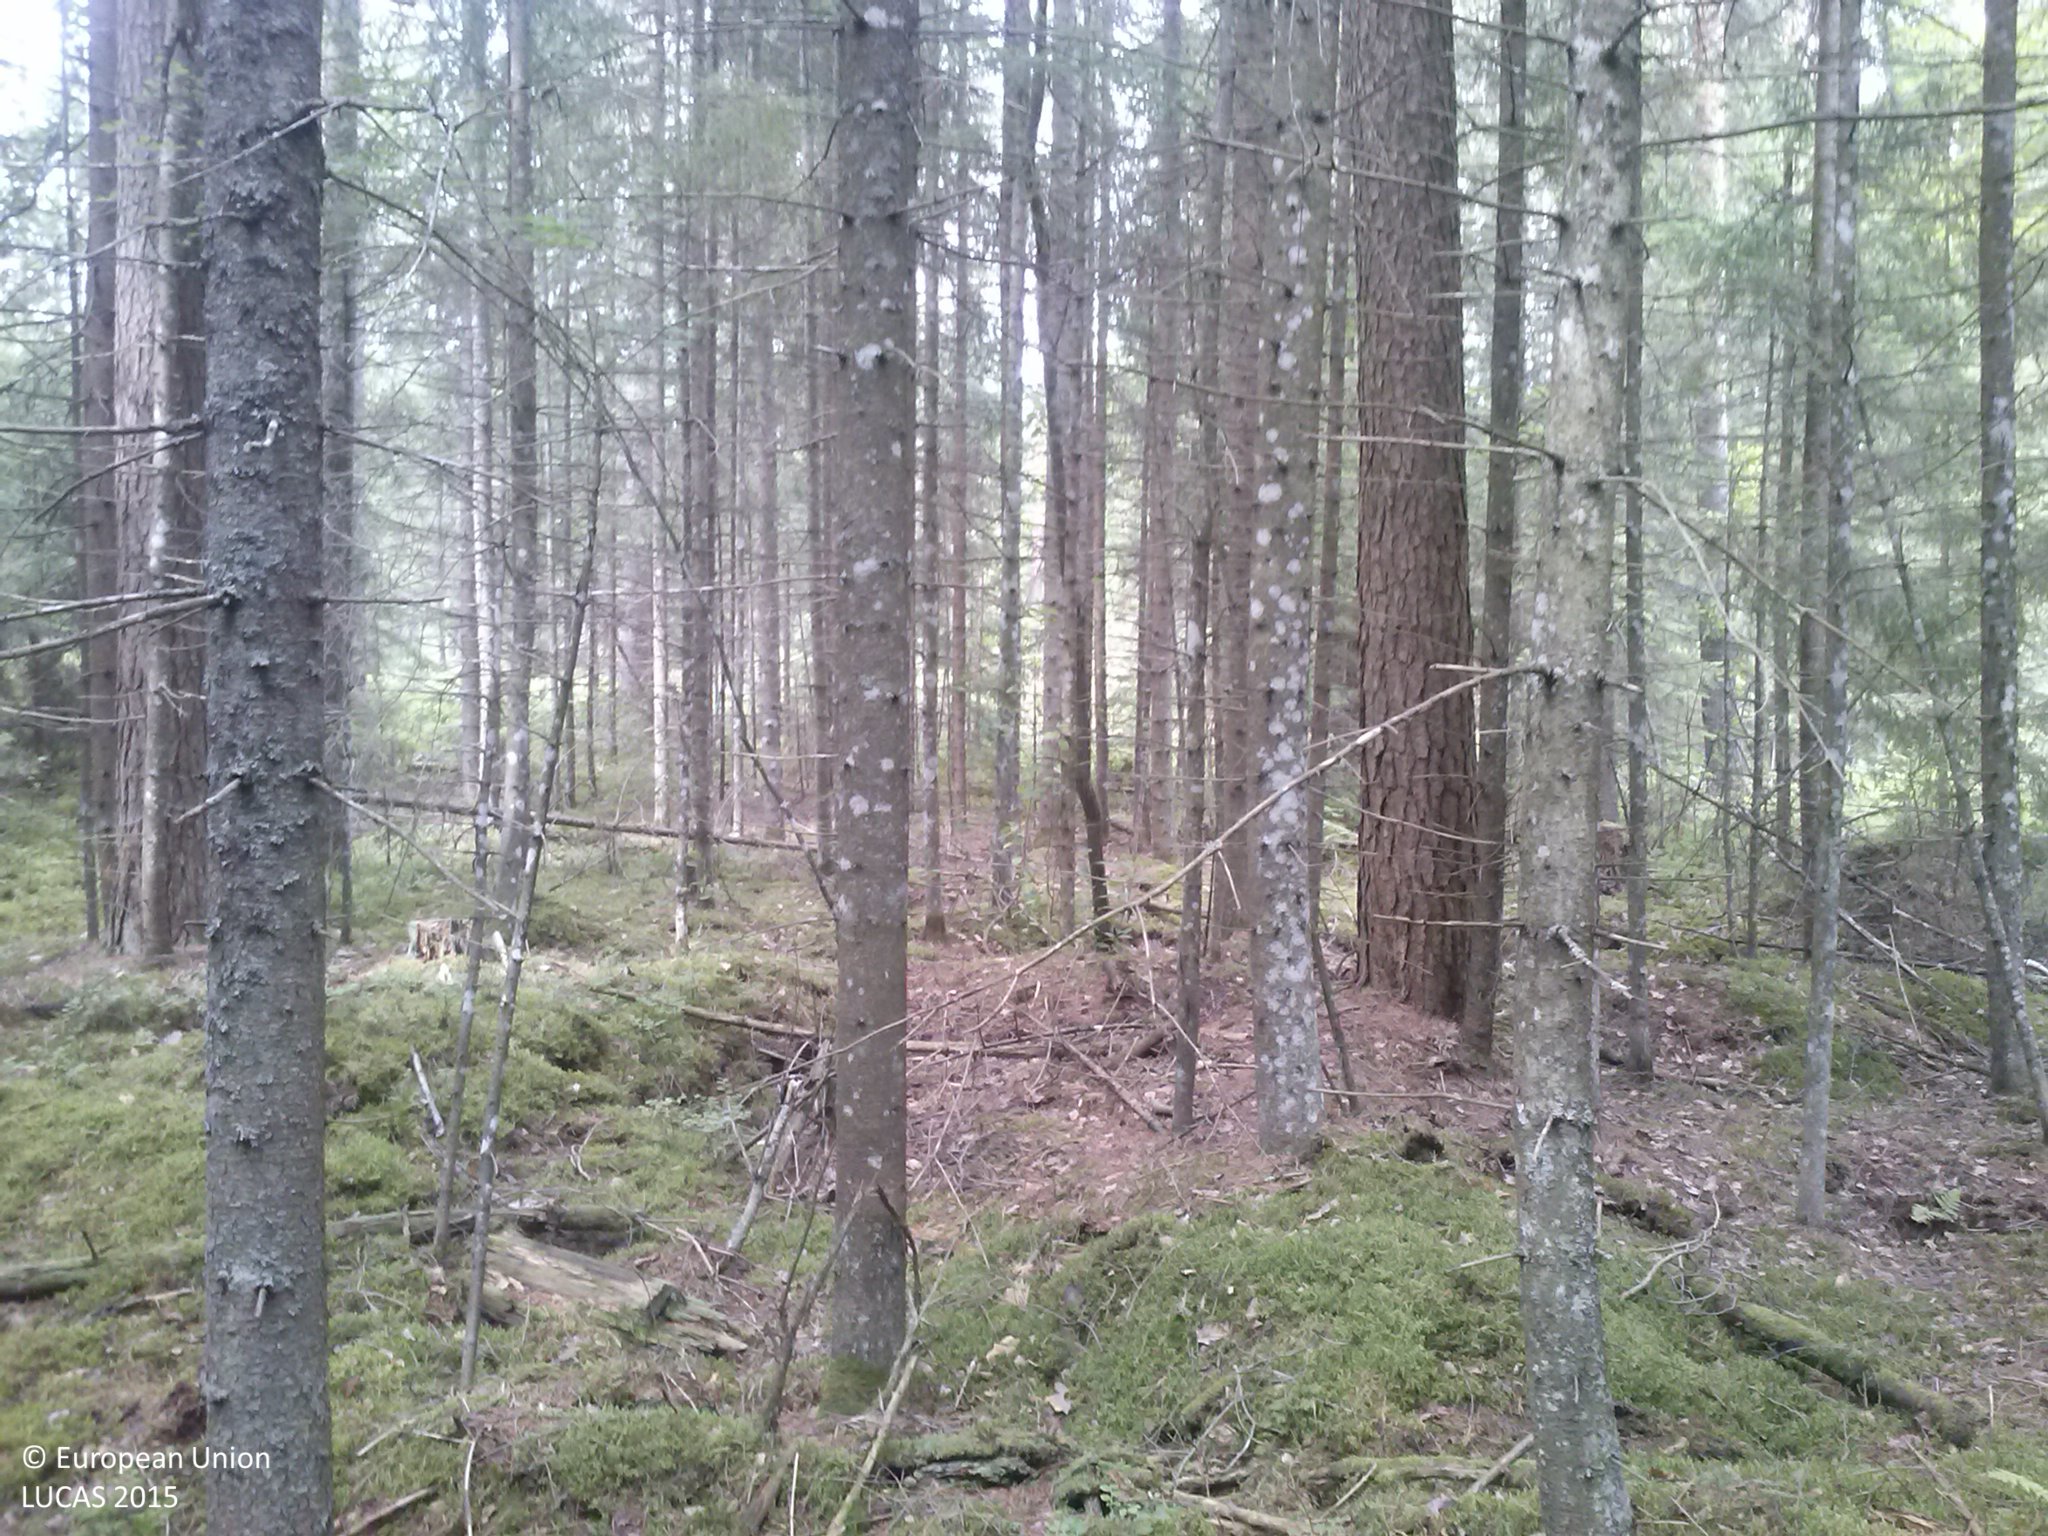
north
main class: Woodland
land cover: Spruce dominated coniferous woodland
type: hemiboreal forest and nemoral coniferous forest and mixed broadleaved-coniferous forest
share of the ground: > 75 %
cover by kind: coniferous forest trees 75 %, herbaceous plants 15 %, lichens and mosses 10 %
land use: Forestry
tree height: > 5 m
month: July
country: LV
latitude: 56.8131
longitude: 27.5256
